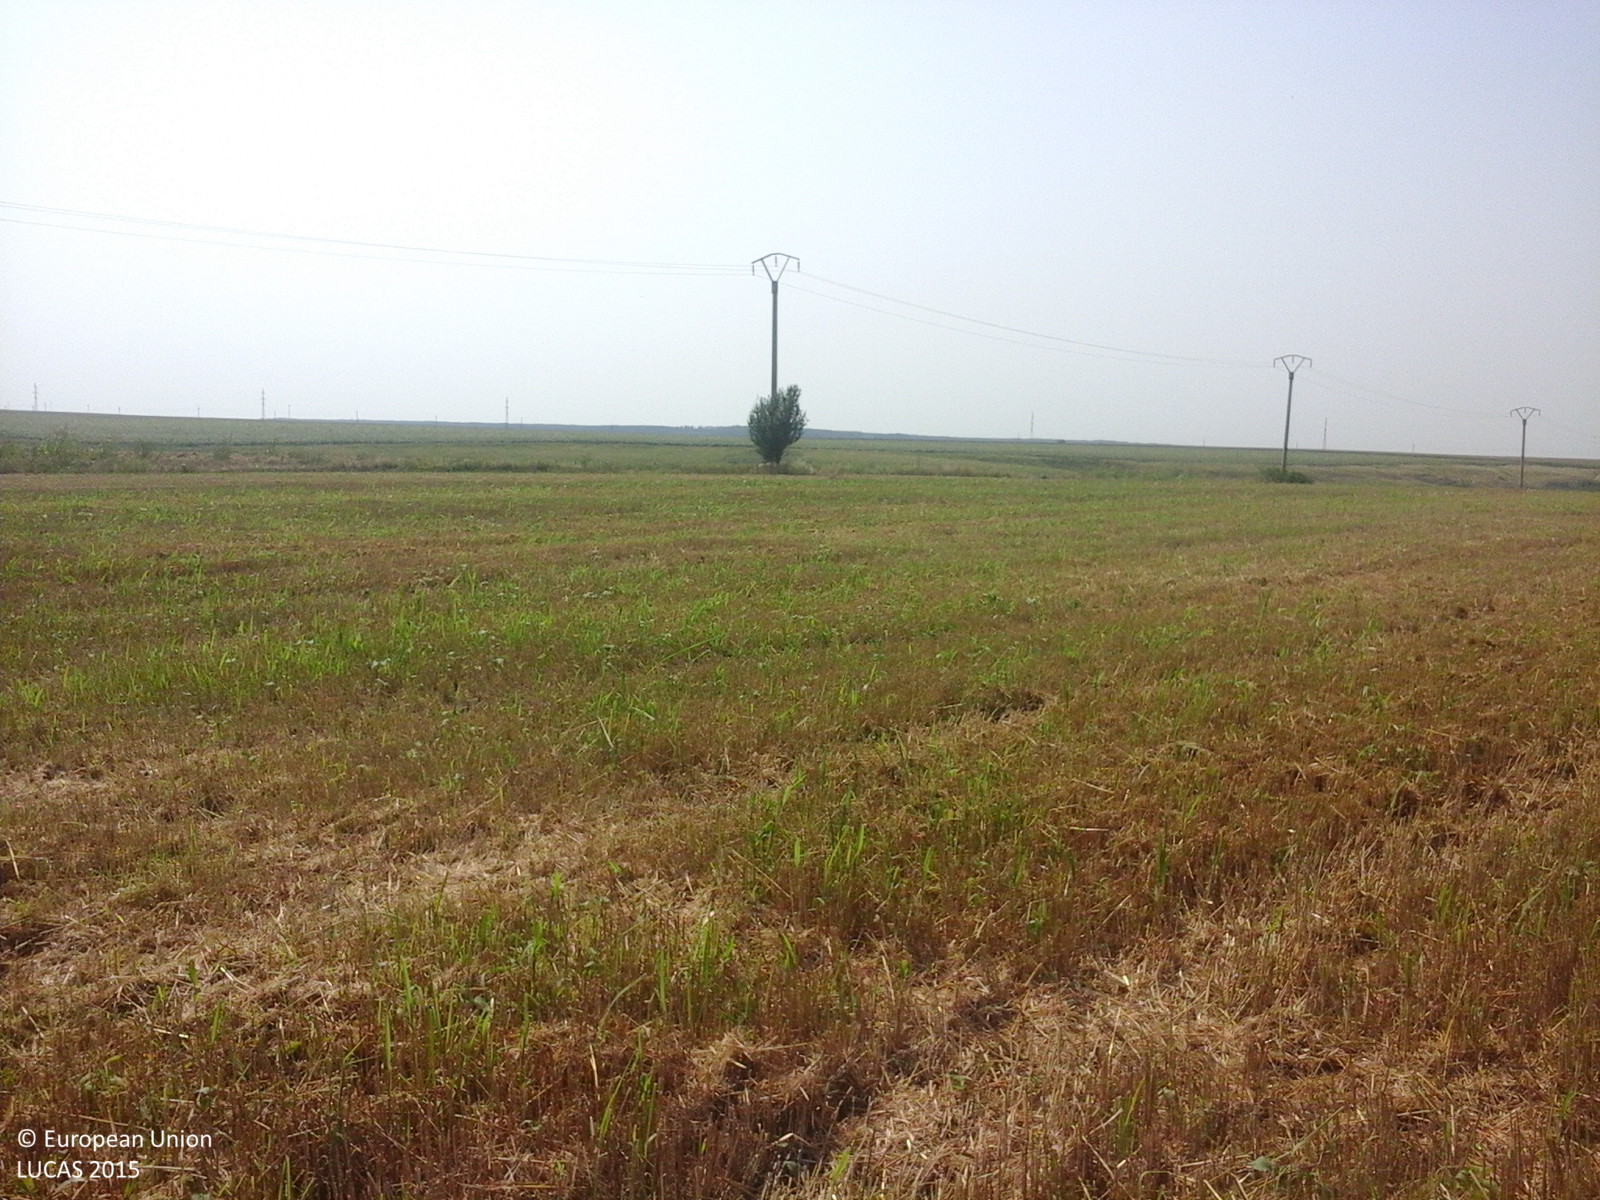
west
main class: Cropland
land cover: Common wheat
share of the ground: 50 - 75 %
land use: Agriculture (excluding fallow land and kitchen gardens)
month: July
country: RO
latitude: 44.5709
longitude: 26.4472
